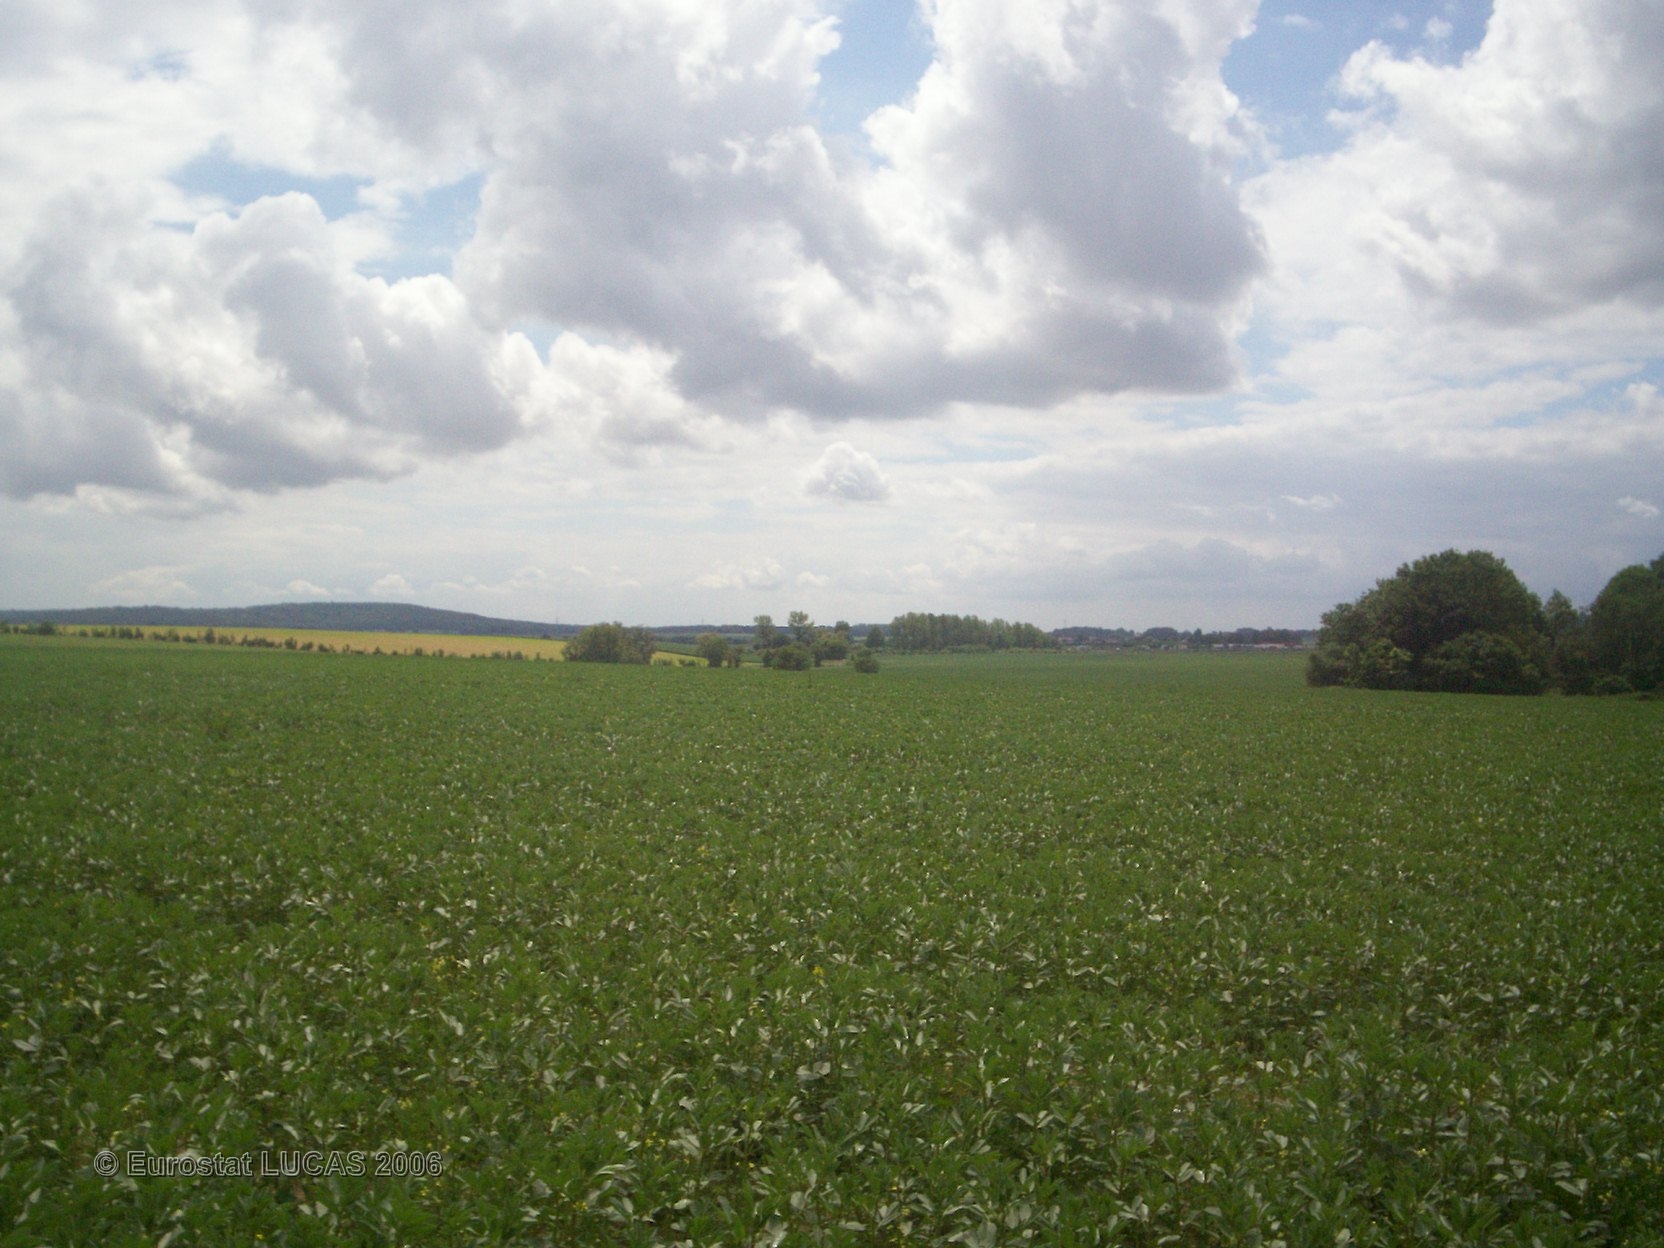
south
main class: Cropland
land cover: Dry pulses
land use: Agriculture (excluding fallow land and kitchen gardens)
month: May
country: FR
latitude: 49.0845
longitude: 2.7191
